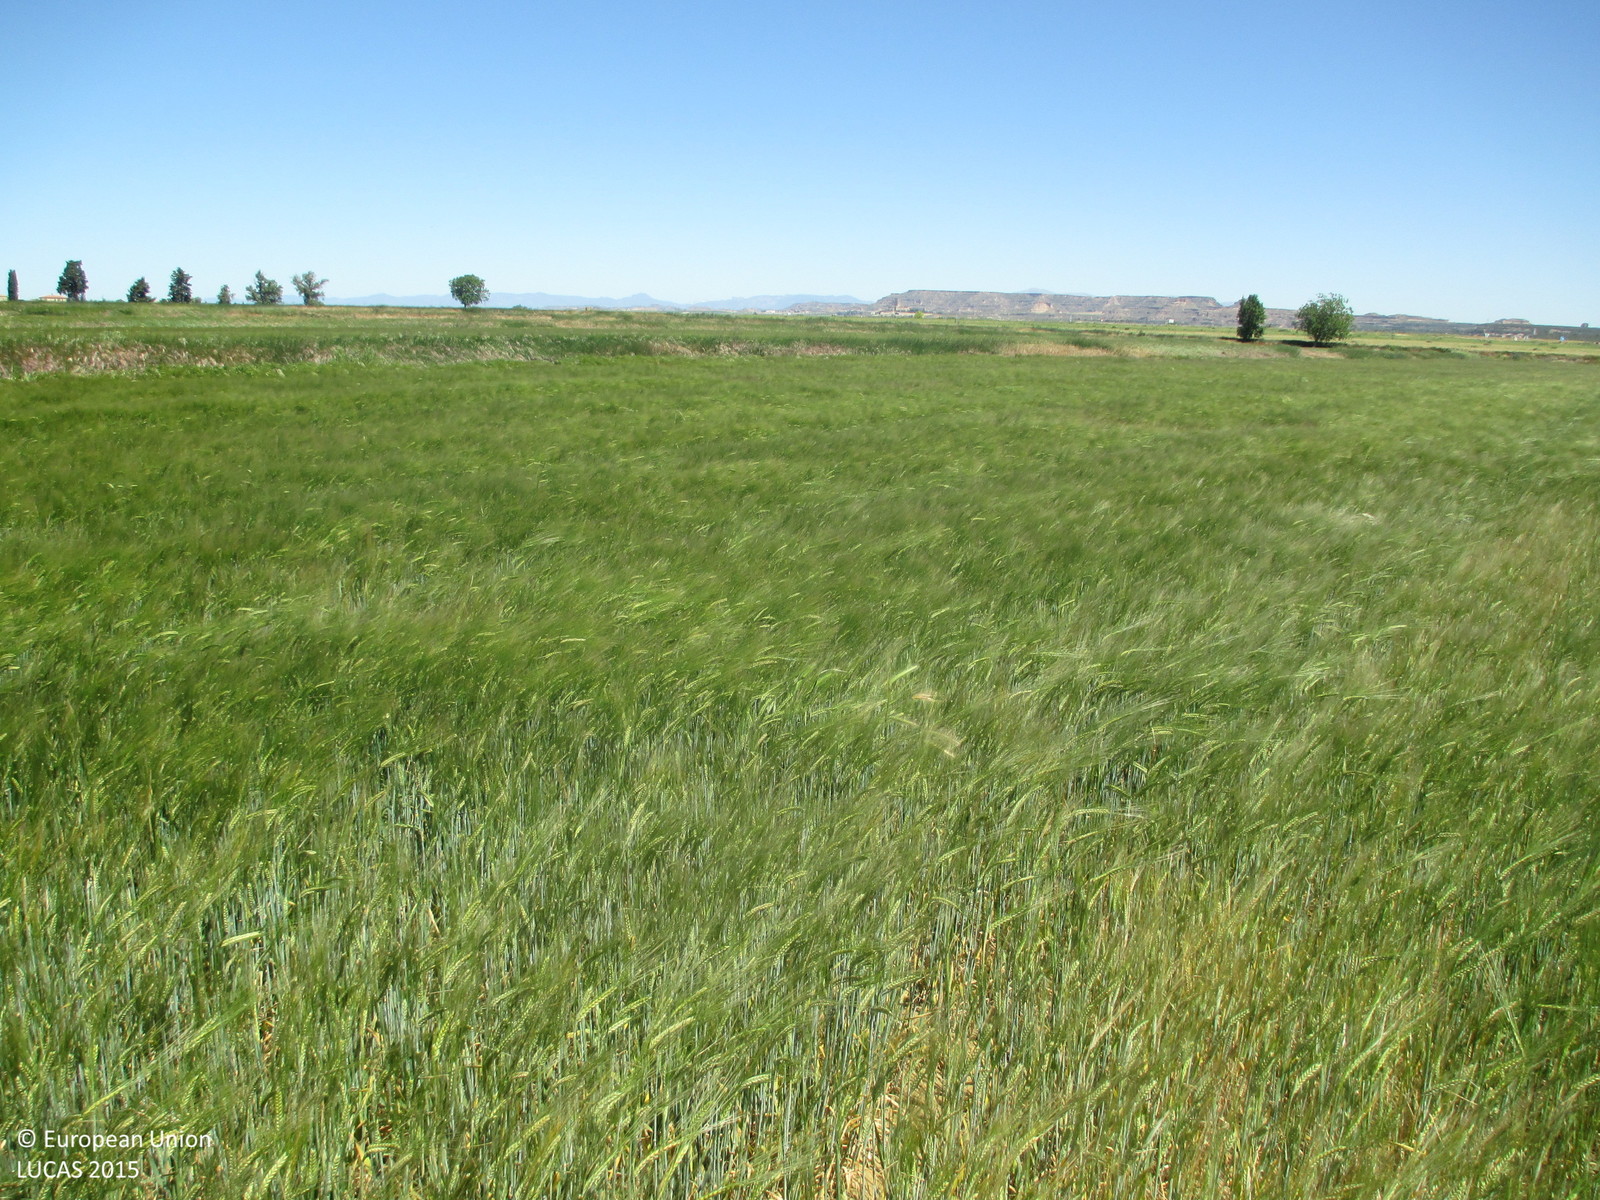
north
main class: Cropland
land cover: Barley
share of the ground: > 75 %
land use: Agriculture (excluding fallow land and kitchen gardens)
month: May
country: ES
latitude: 41.8577
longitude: -0.2704
